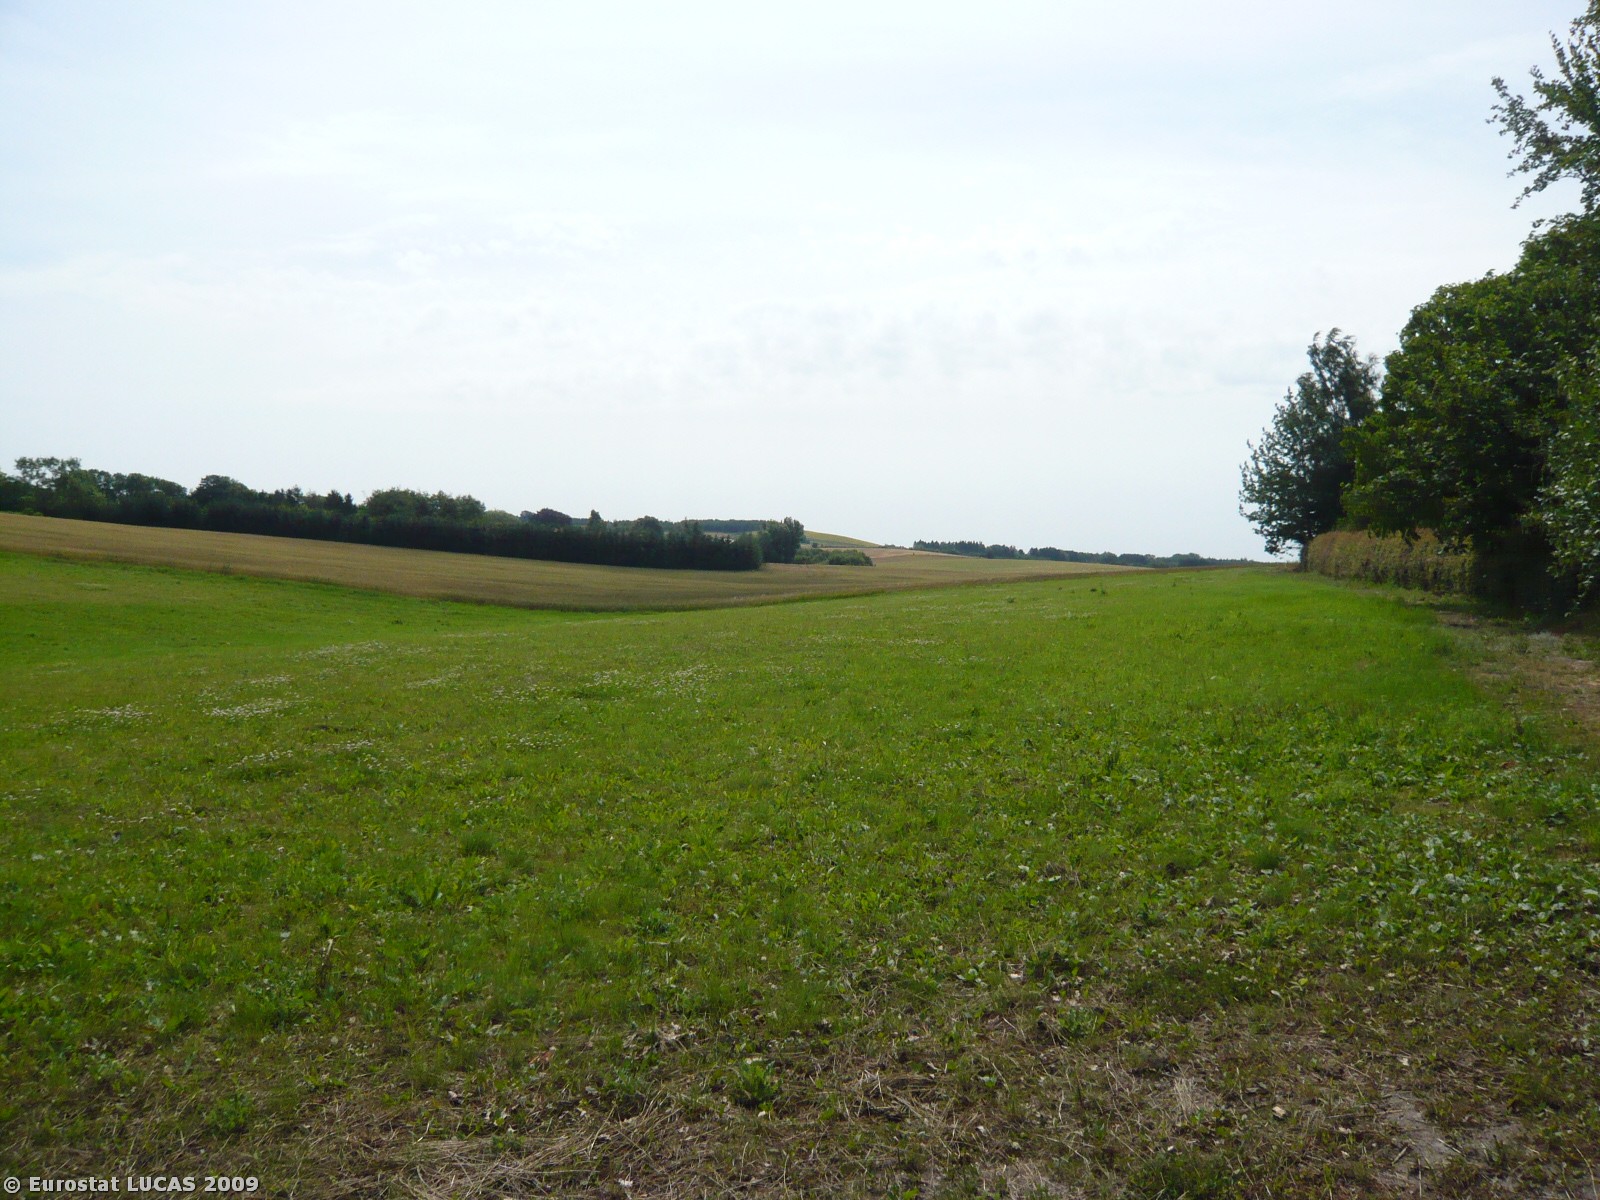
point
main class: Cropland
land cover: Common wheat
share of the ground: > 75 %
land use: Agriculture (excluding fallow land and kitchen gardens)
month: July
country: DK
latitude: 55.5640
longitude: 11.7902
